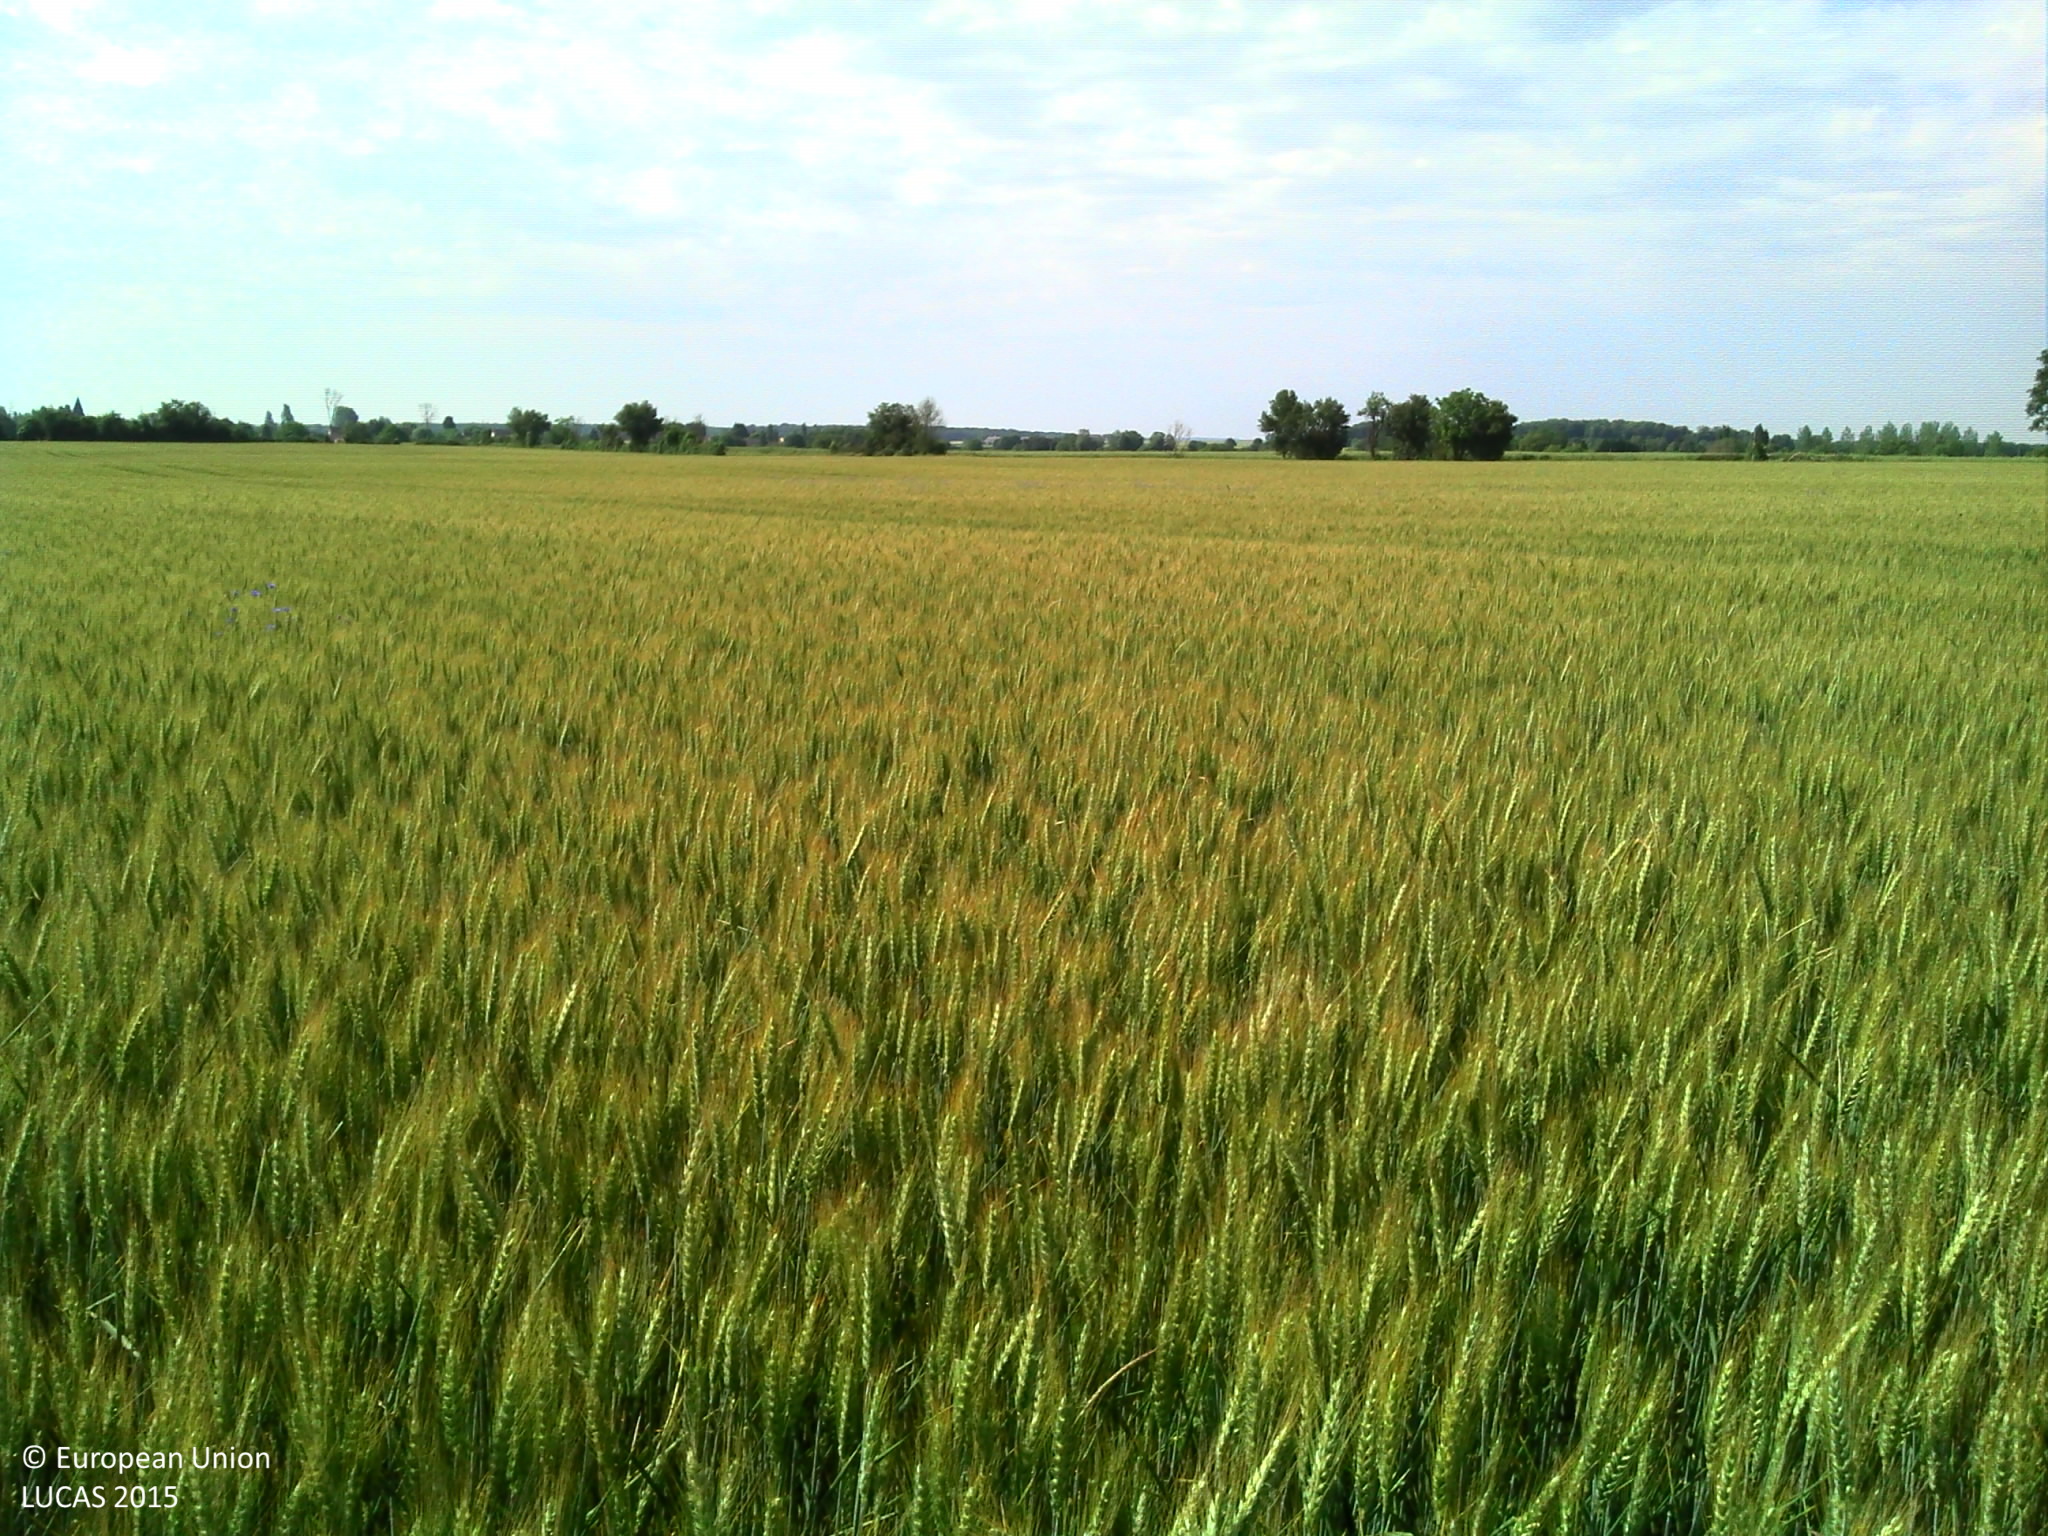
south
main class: Cropland
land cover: Common wheat
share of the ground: > 75 %
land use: Agriculture (excluding fallow land and kitchen gardens)
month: June
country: FR
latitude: 46.7562
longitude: 2.7556
